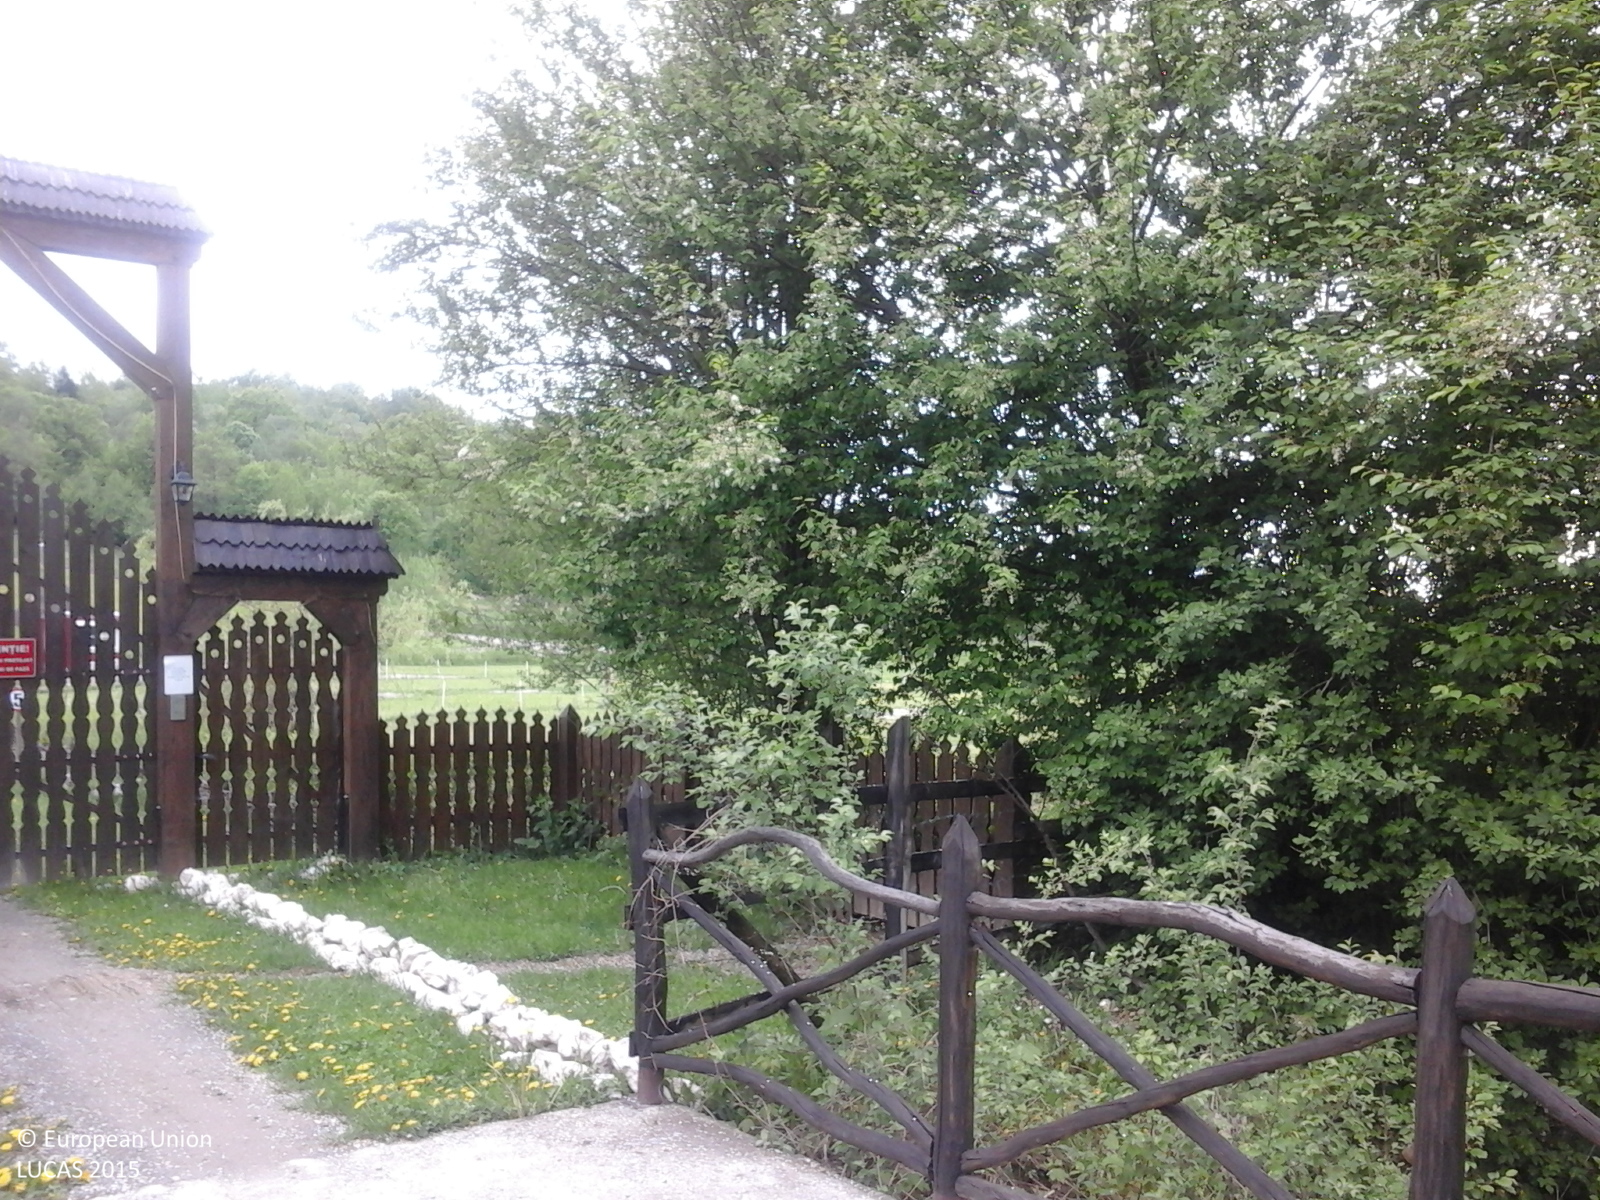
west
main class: Woodland
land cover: Broadleaved woodland
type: beech forest
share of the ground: > 75 %
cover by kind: broadleaved forest trees 100 %
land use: Forestry
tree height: > 5 m
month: May
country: RO
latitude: 45.5414
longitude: 25.5083
